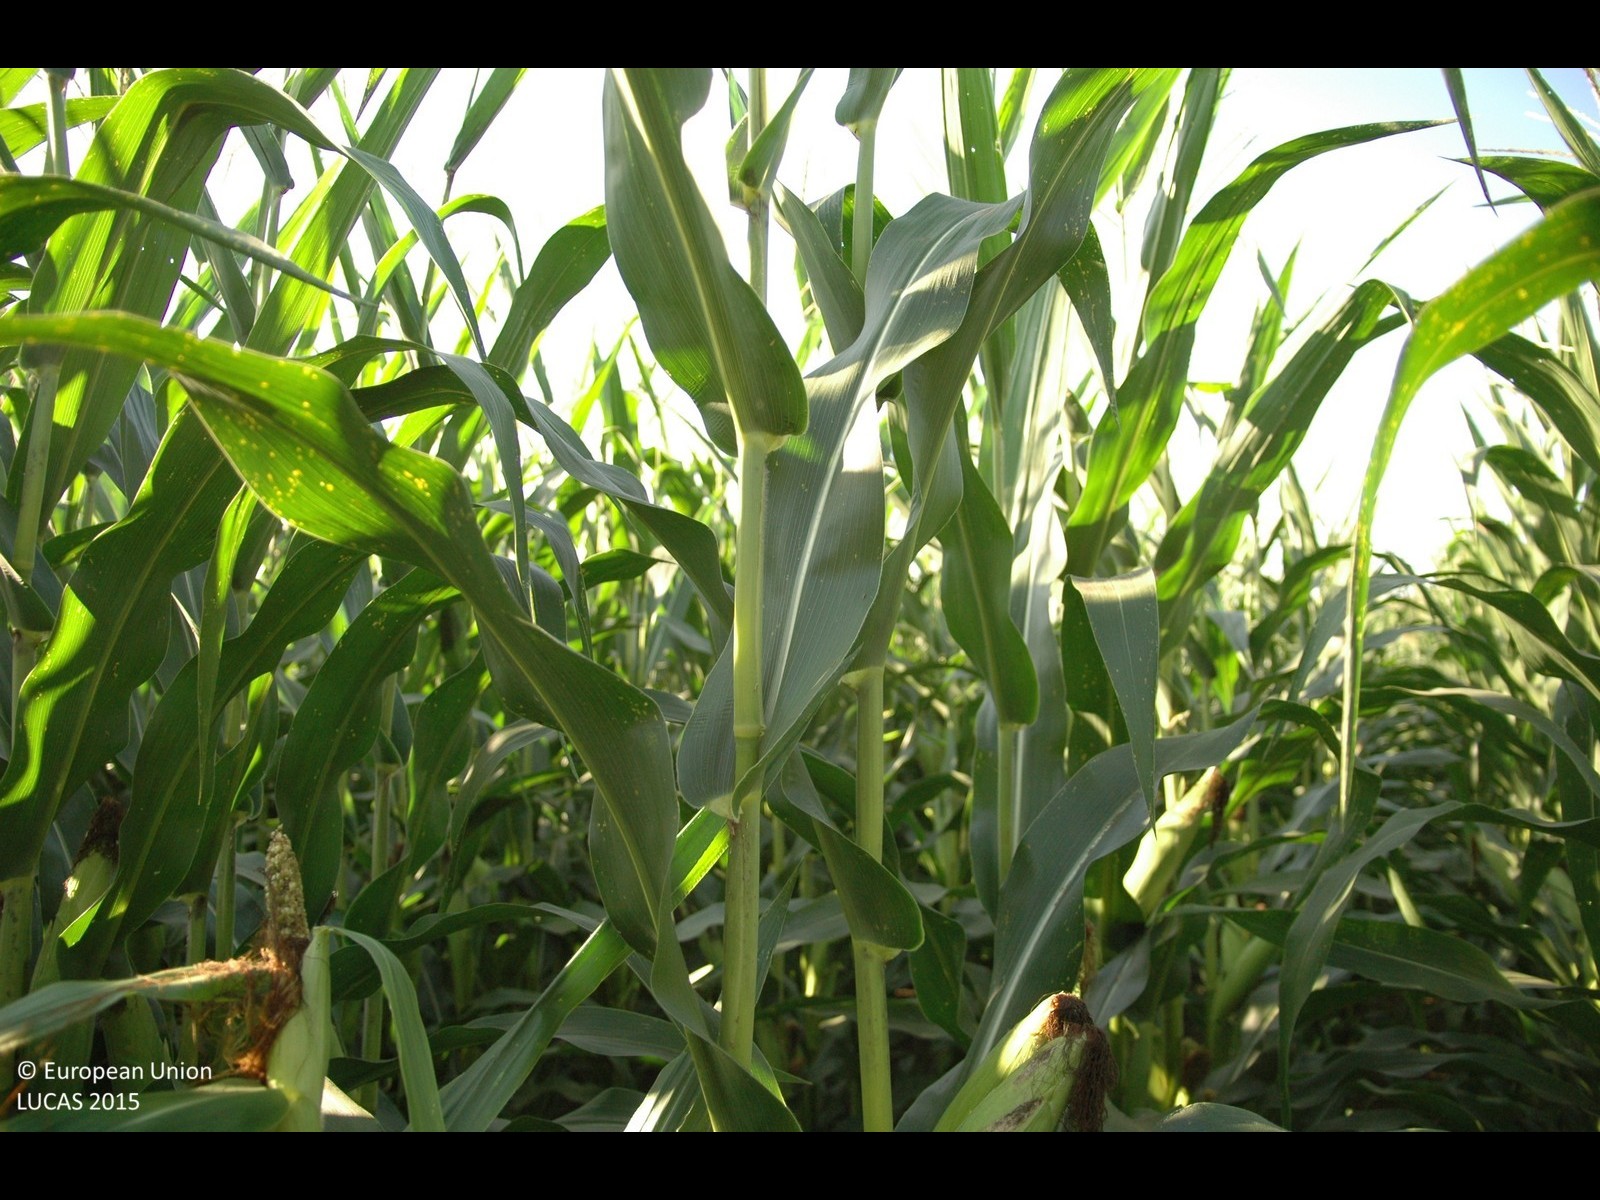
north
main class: Cropland
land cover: Maize
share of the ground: > 75 %
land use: Agriculture (excluding fallow land and kitchen gardens)
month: July
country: HR
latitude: 46.2637
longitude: 16.7609
